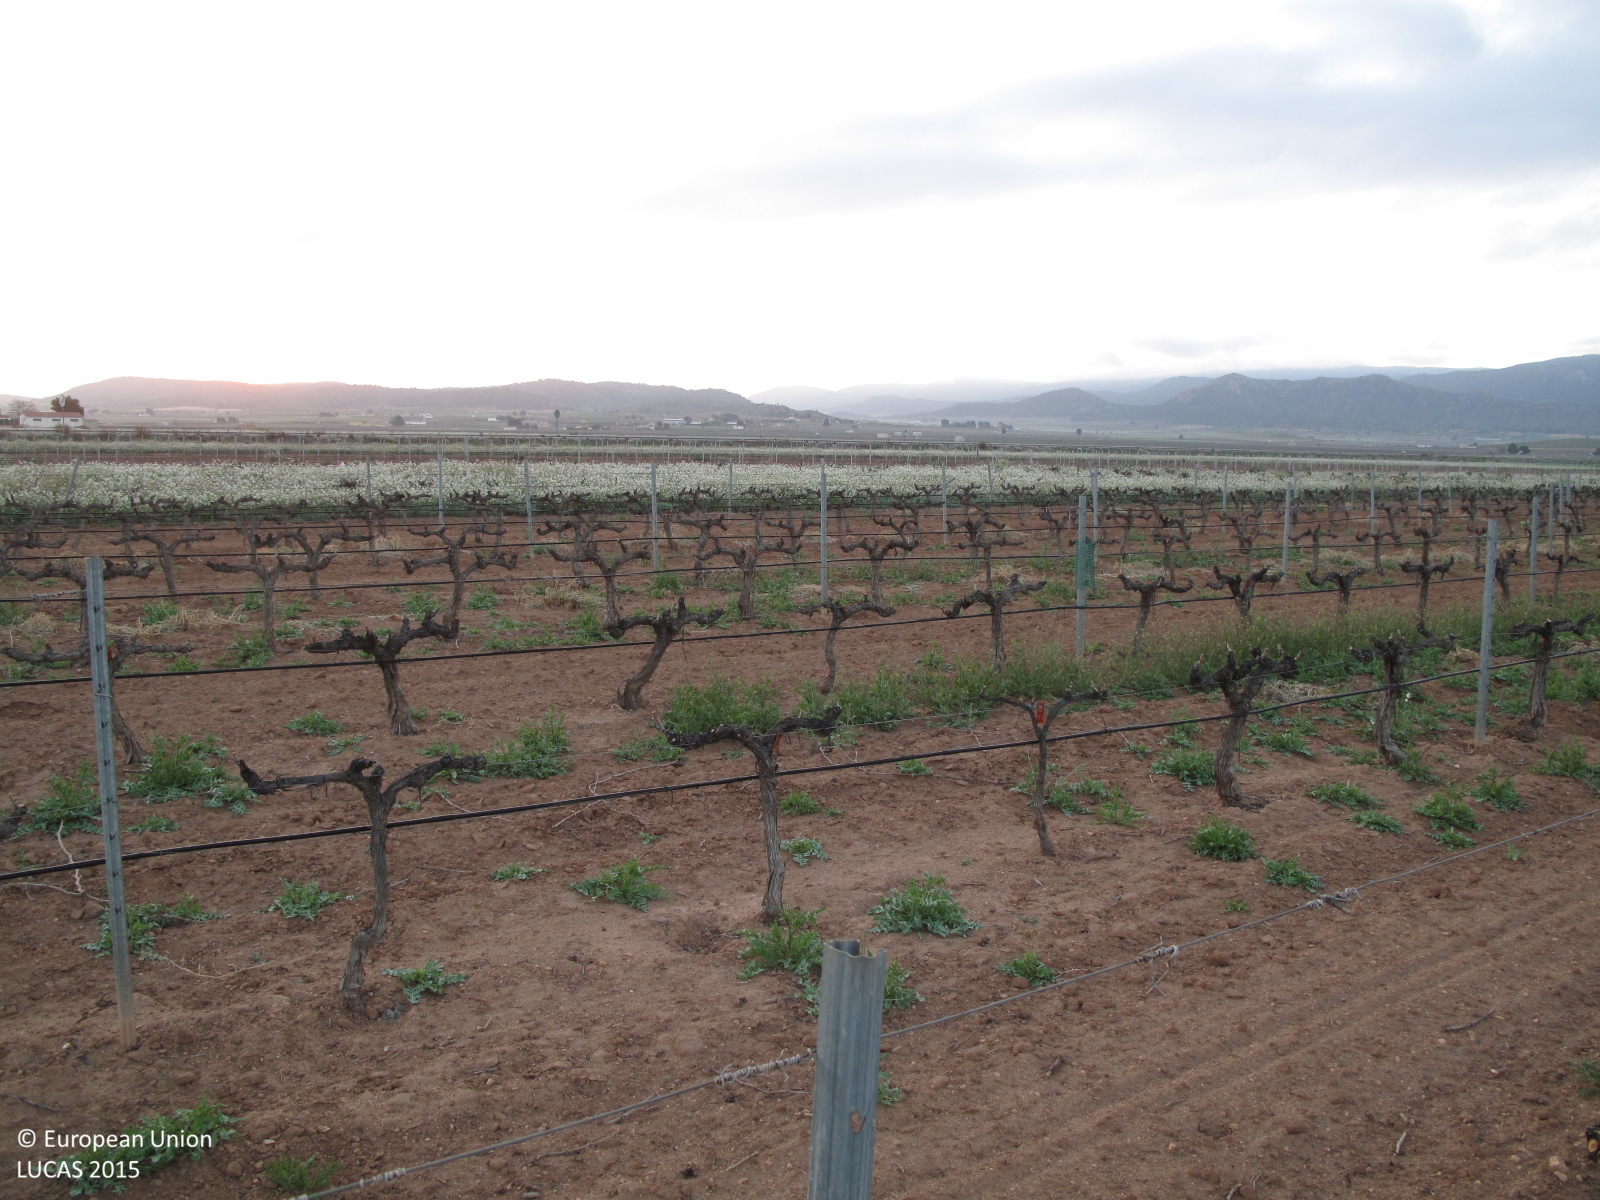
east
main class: Cropland
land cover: Vineyards
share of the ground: < 10 %
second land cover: Other bare soil
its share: > 75 %
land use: Agriculture (excluding fallow land and kitchen gardens)
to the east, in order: Vineyards; Other bare soil; Vineyards; Spontaneously vegetated surfaces; Tracks; Grass margins; Paved roads, cycling and walking lanes; Spontaneously vegetated surfaces
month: April
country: ES
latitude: 38.5622
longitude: -1.0650
